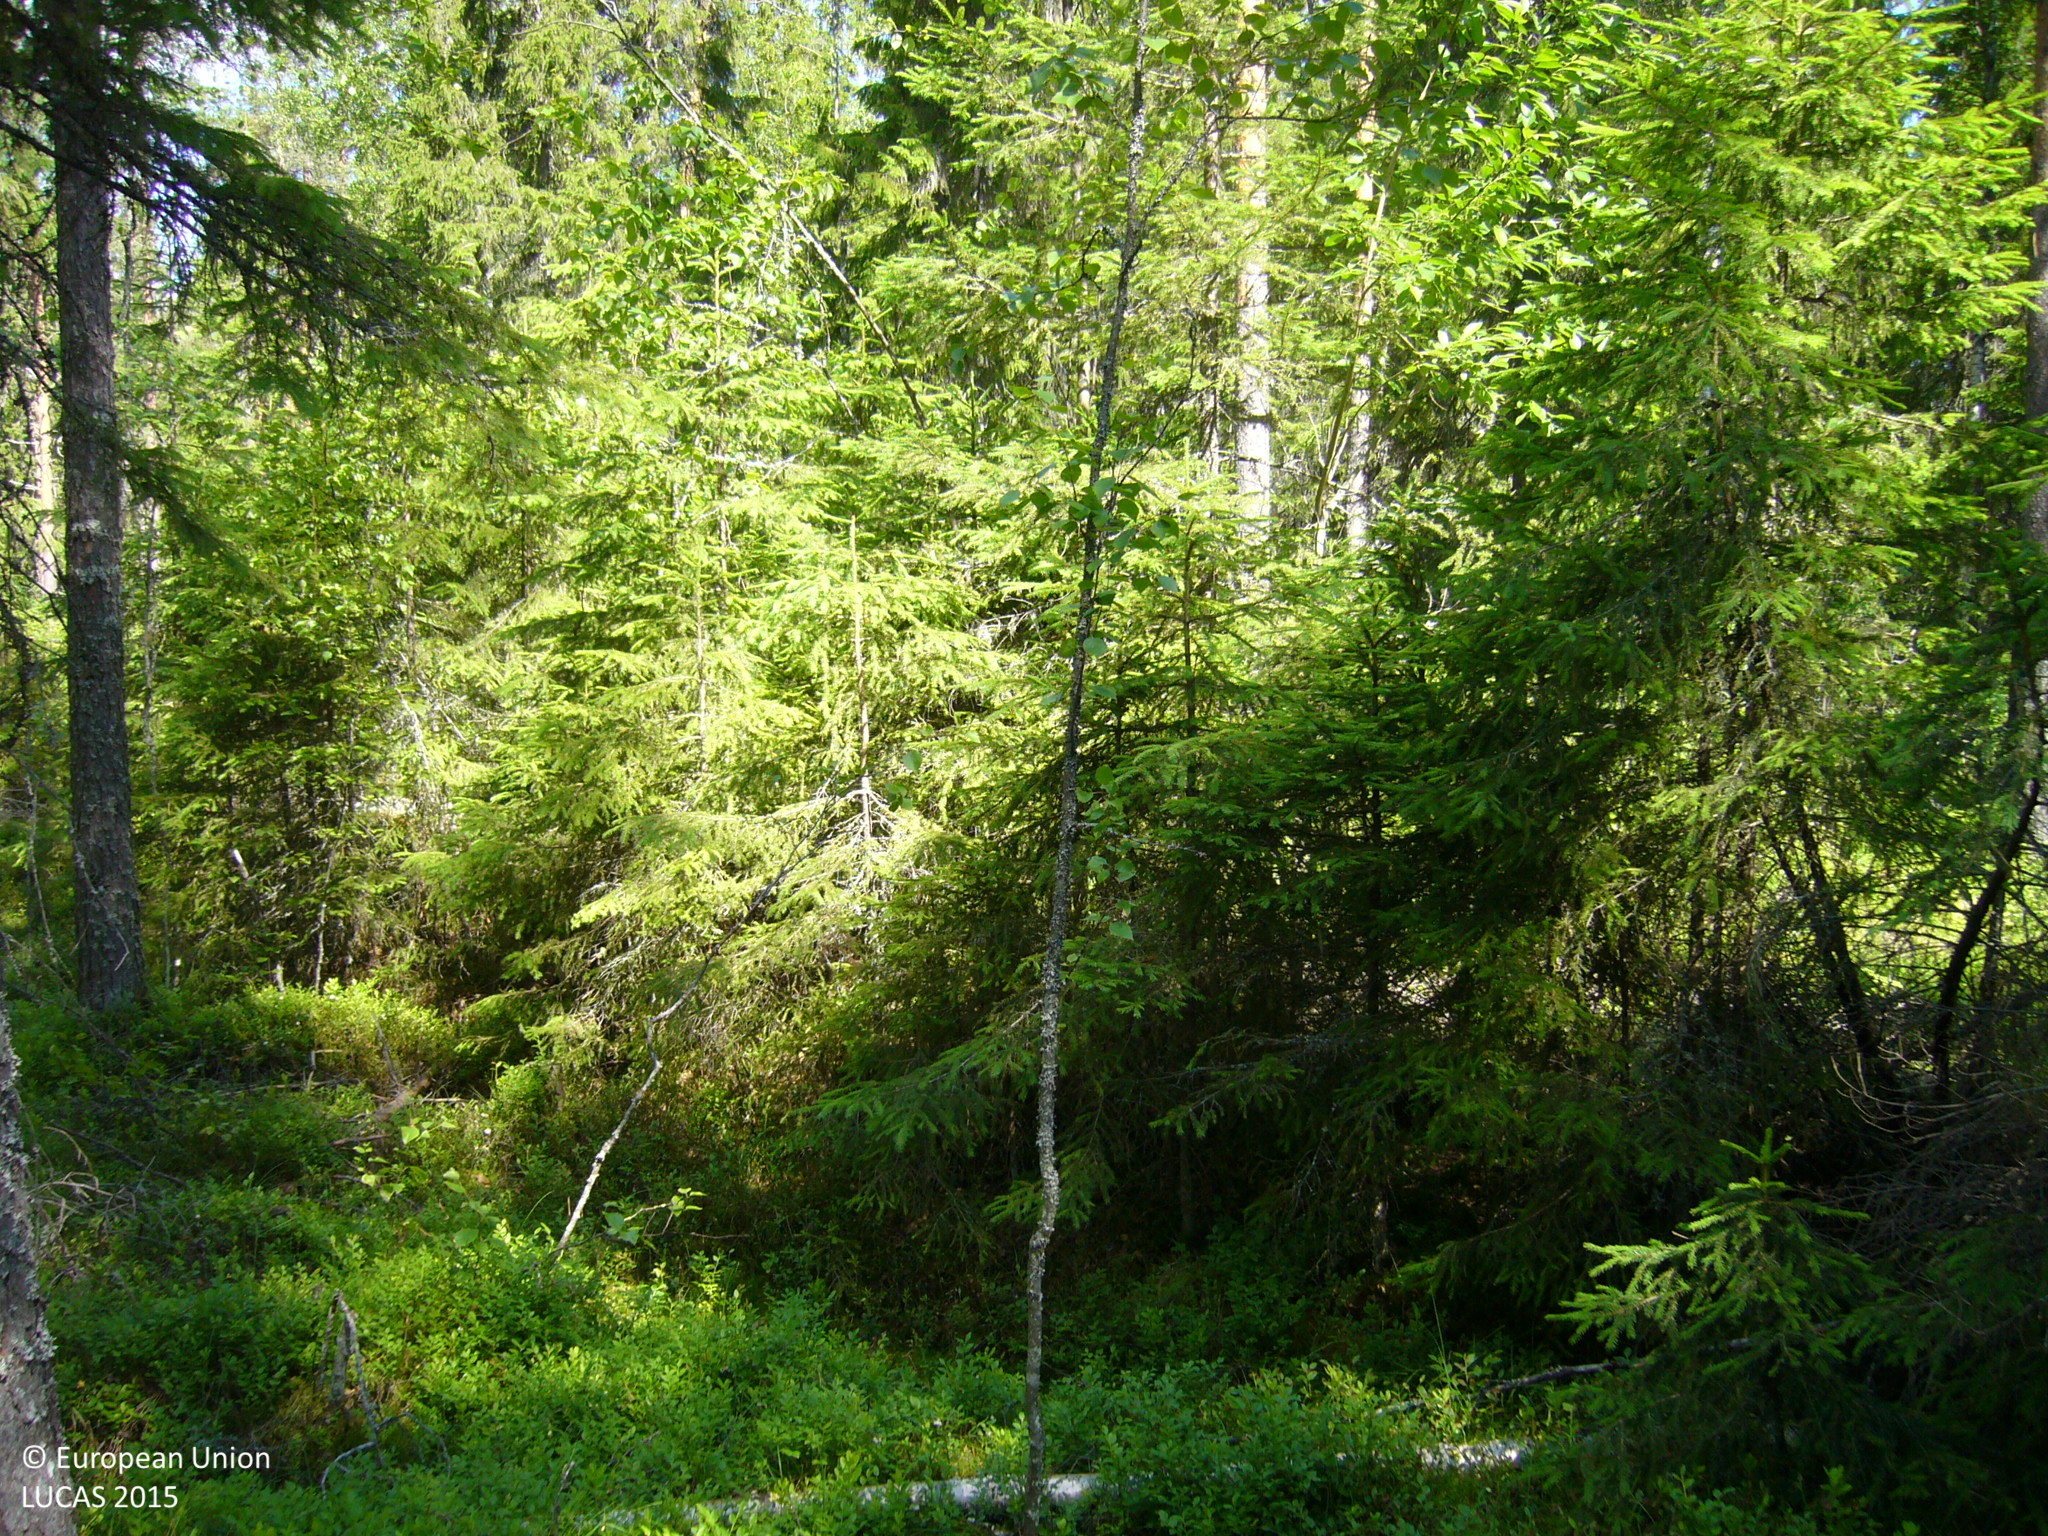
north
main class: Woodland
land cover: Spruce dominated coniferous woodland
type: boreal forest
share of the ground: 50 - 75 %
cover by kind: coniferous forest trees 50 %, shrubs 40 %, broadleaved forest trees 10 %
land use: Forestry
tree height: > 5 m
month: July
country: FI
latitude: 63.3094
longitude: 26.2662
